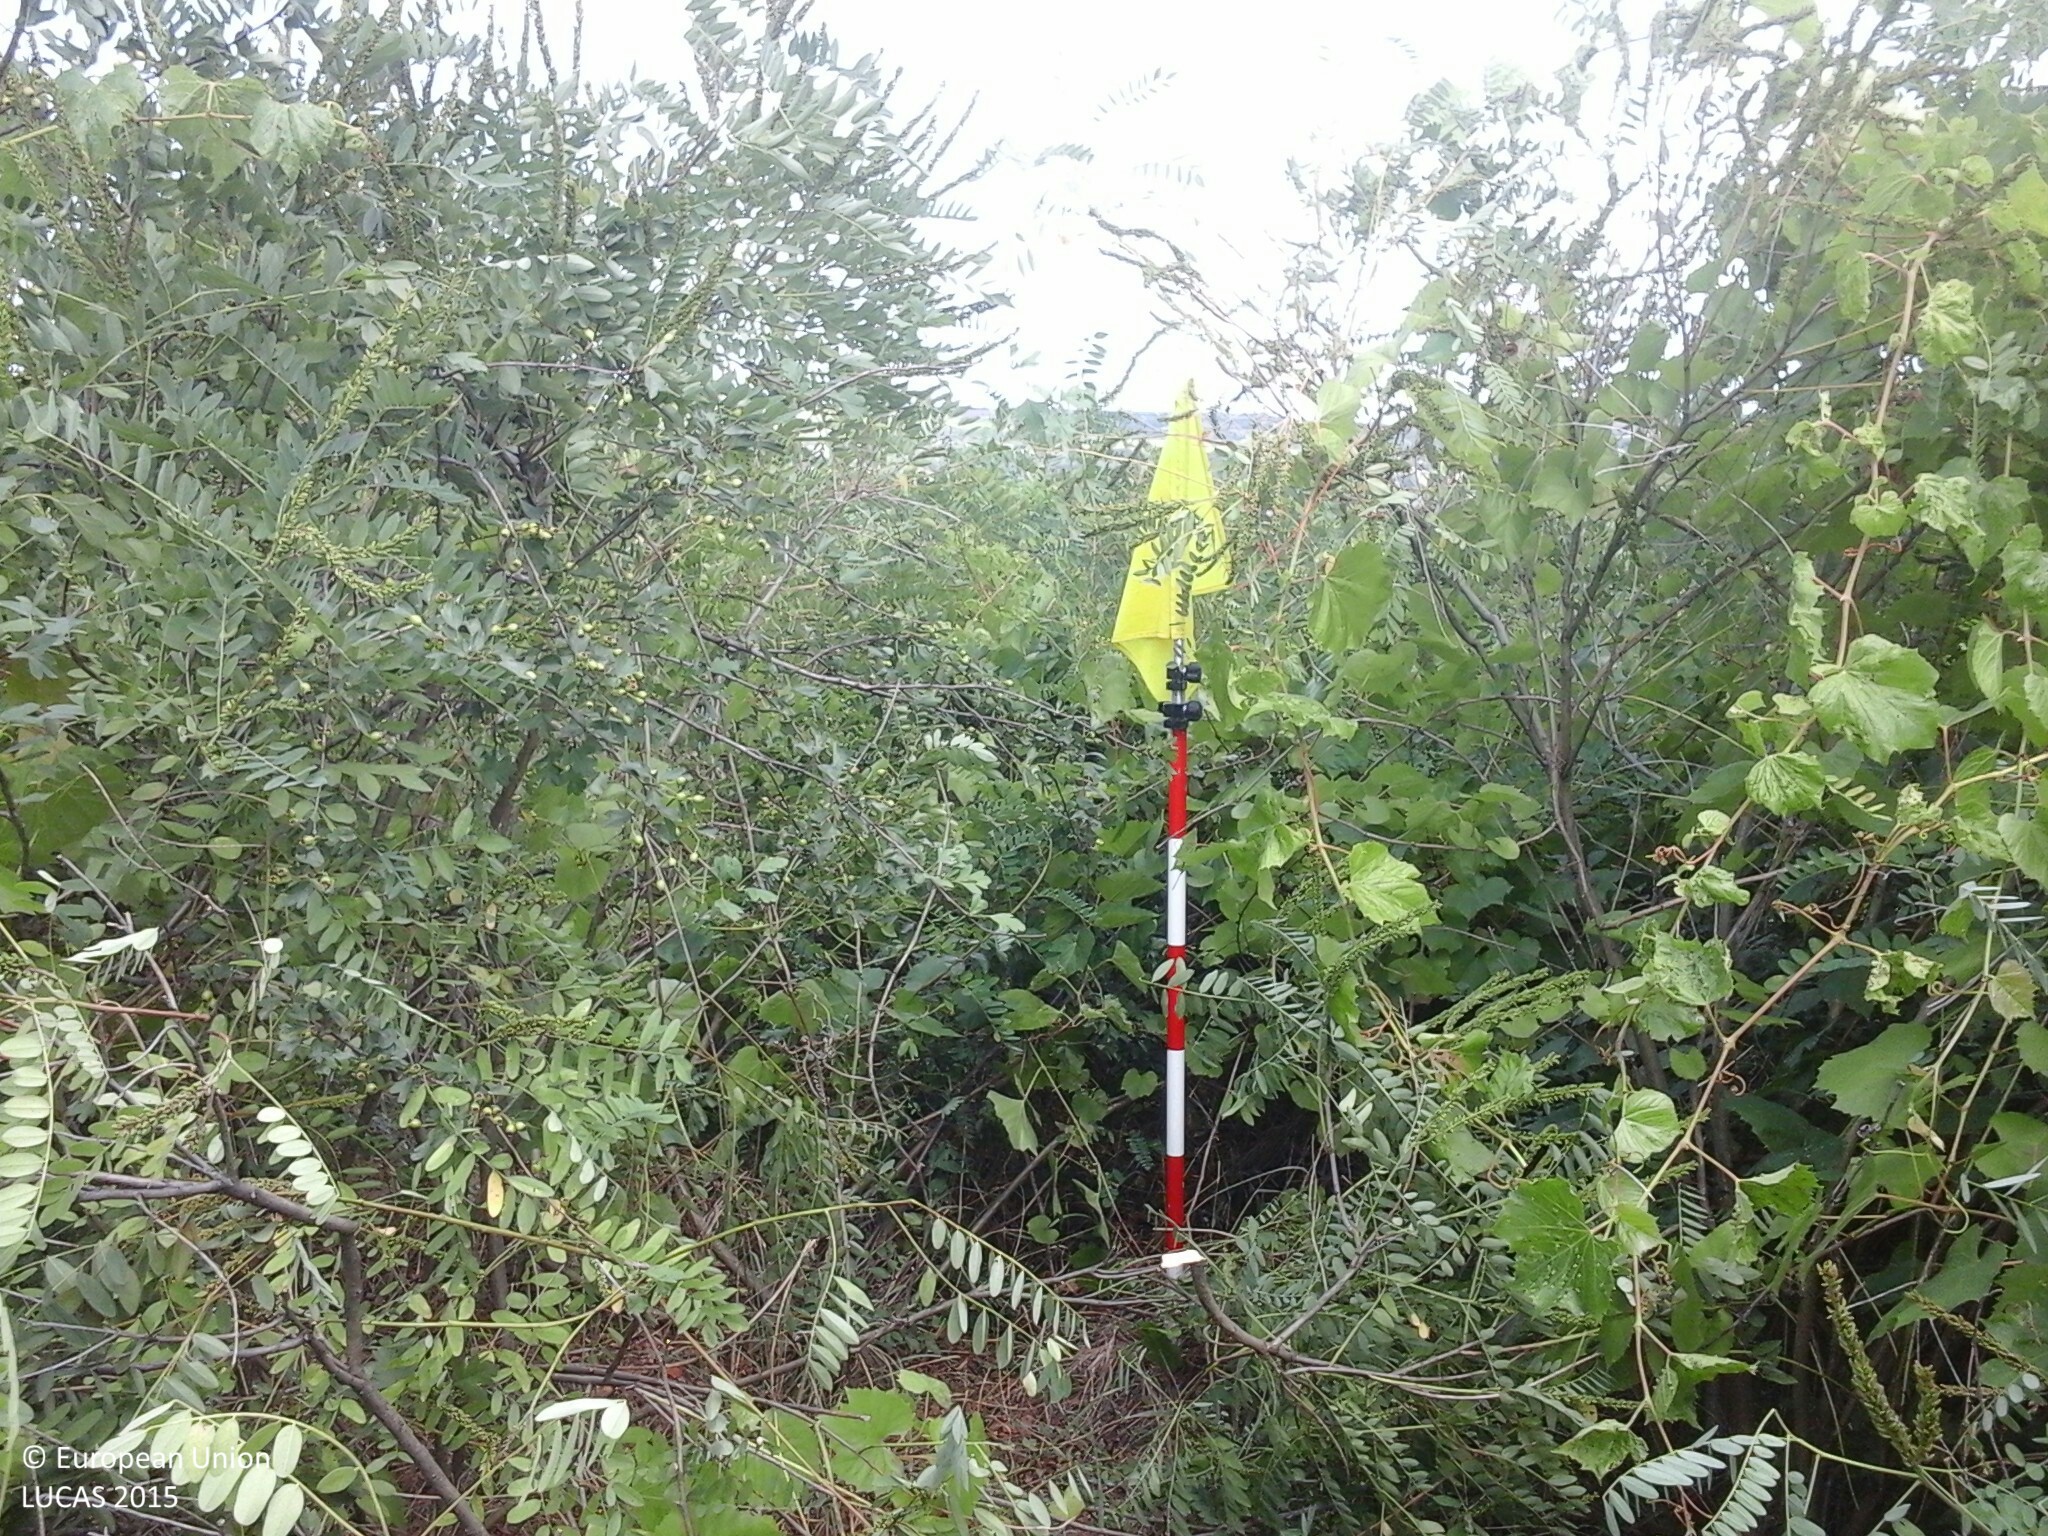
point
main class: Cropland
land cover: Vineyards
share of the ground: 25 - 50 %
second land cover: Spontaneously vegetated surfaces
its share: 25 - 50 %
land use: Agriculture (excluding fallow land and kitchen gardens)
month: July
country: HU
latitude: 47.8404
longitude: 20.3865
